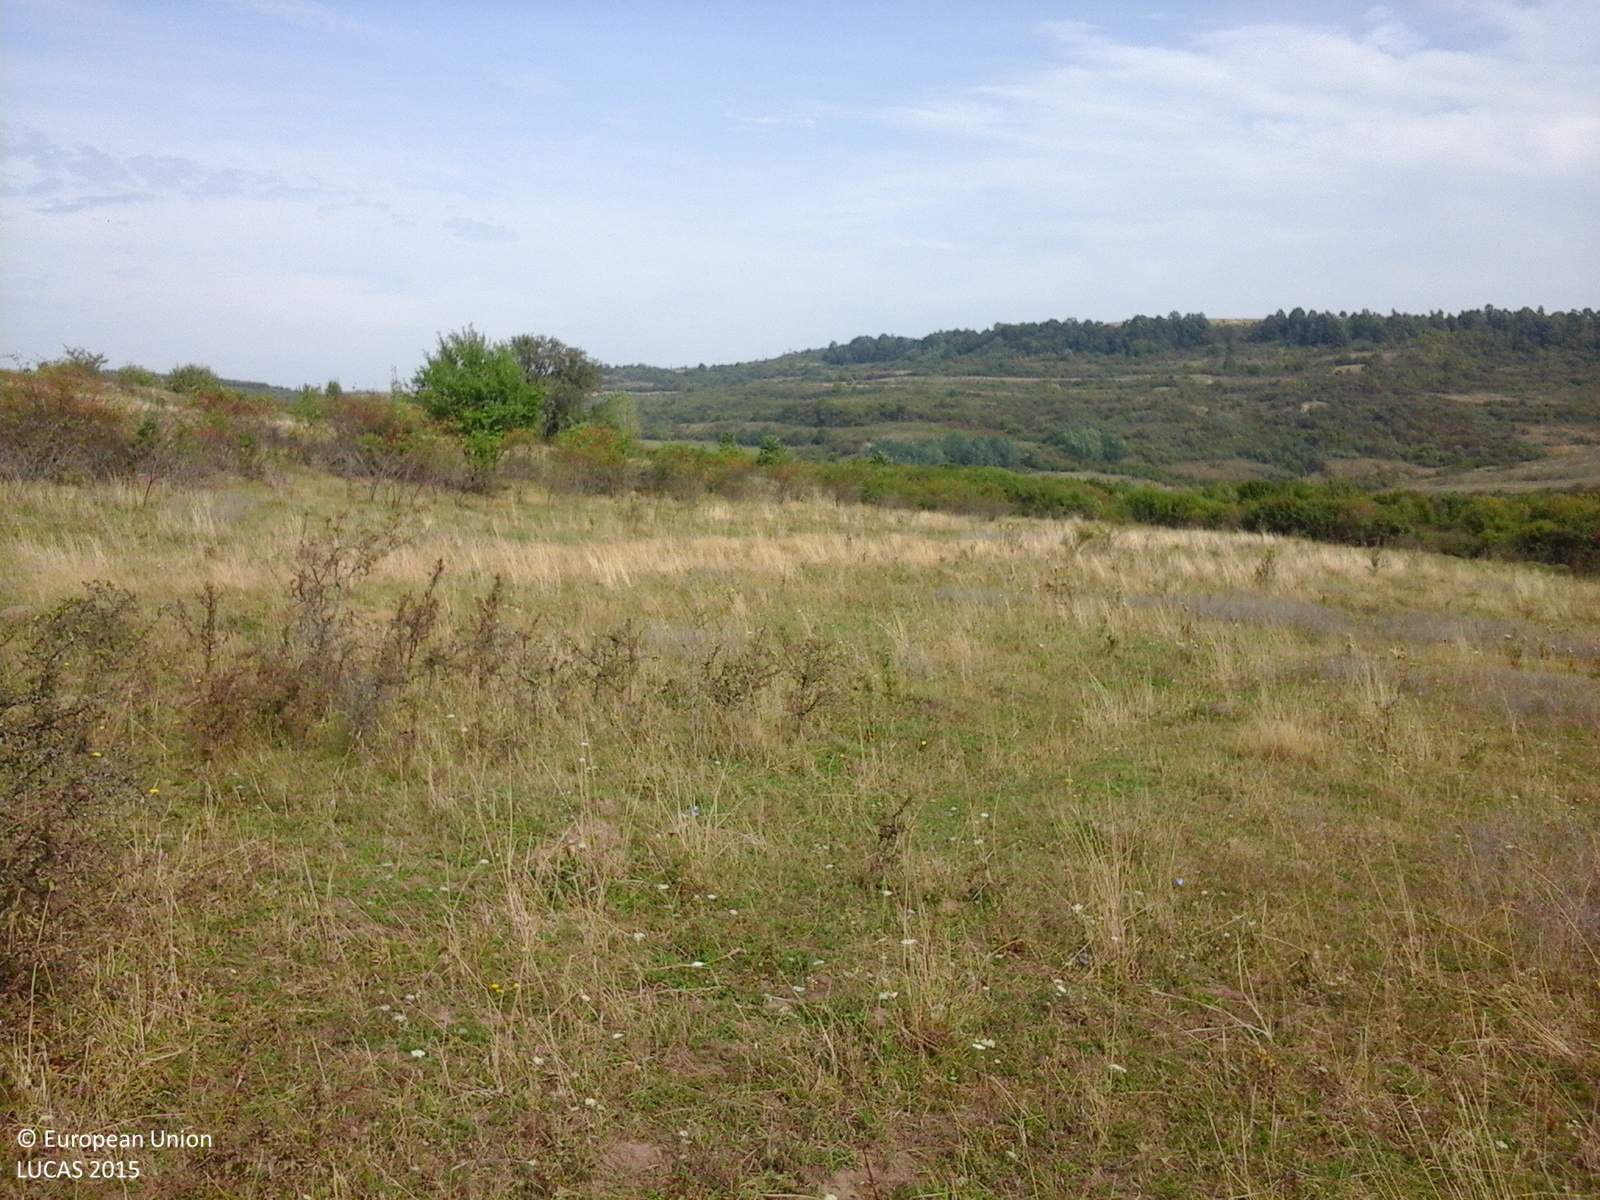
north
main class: Grassland
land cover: Spontaneously vegetated surfaces
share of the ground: > 75 %
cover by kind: herbaceous plants 100 %
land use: Fallow land
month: September
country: RO
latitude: 47.1545
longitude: 23.6192
